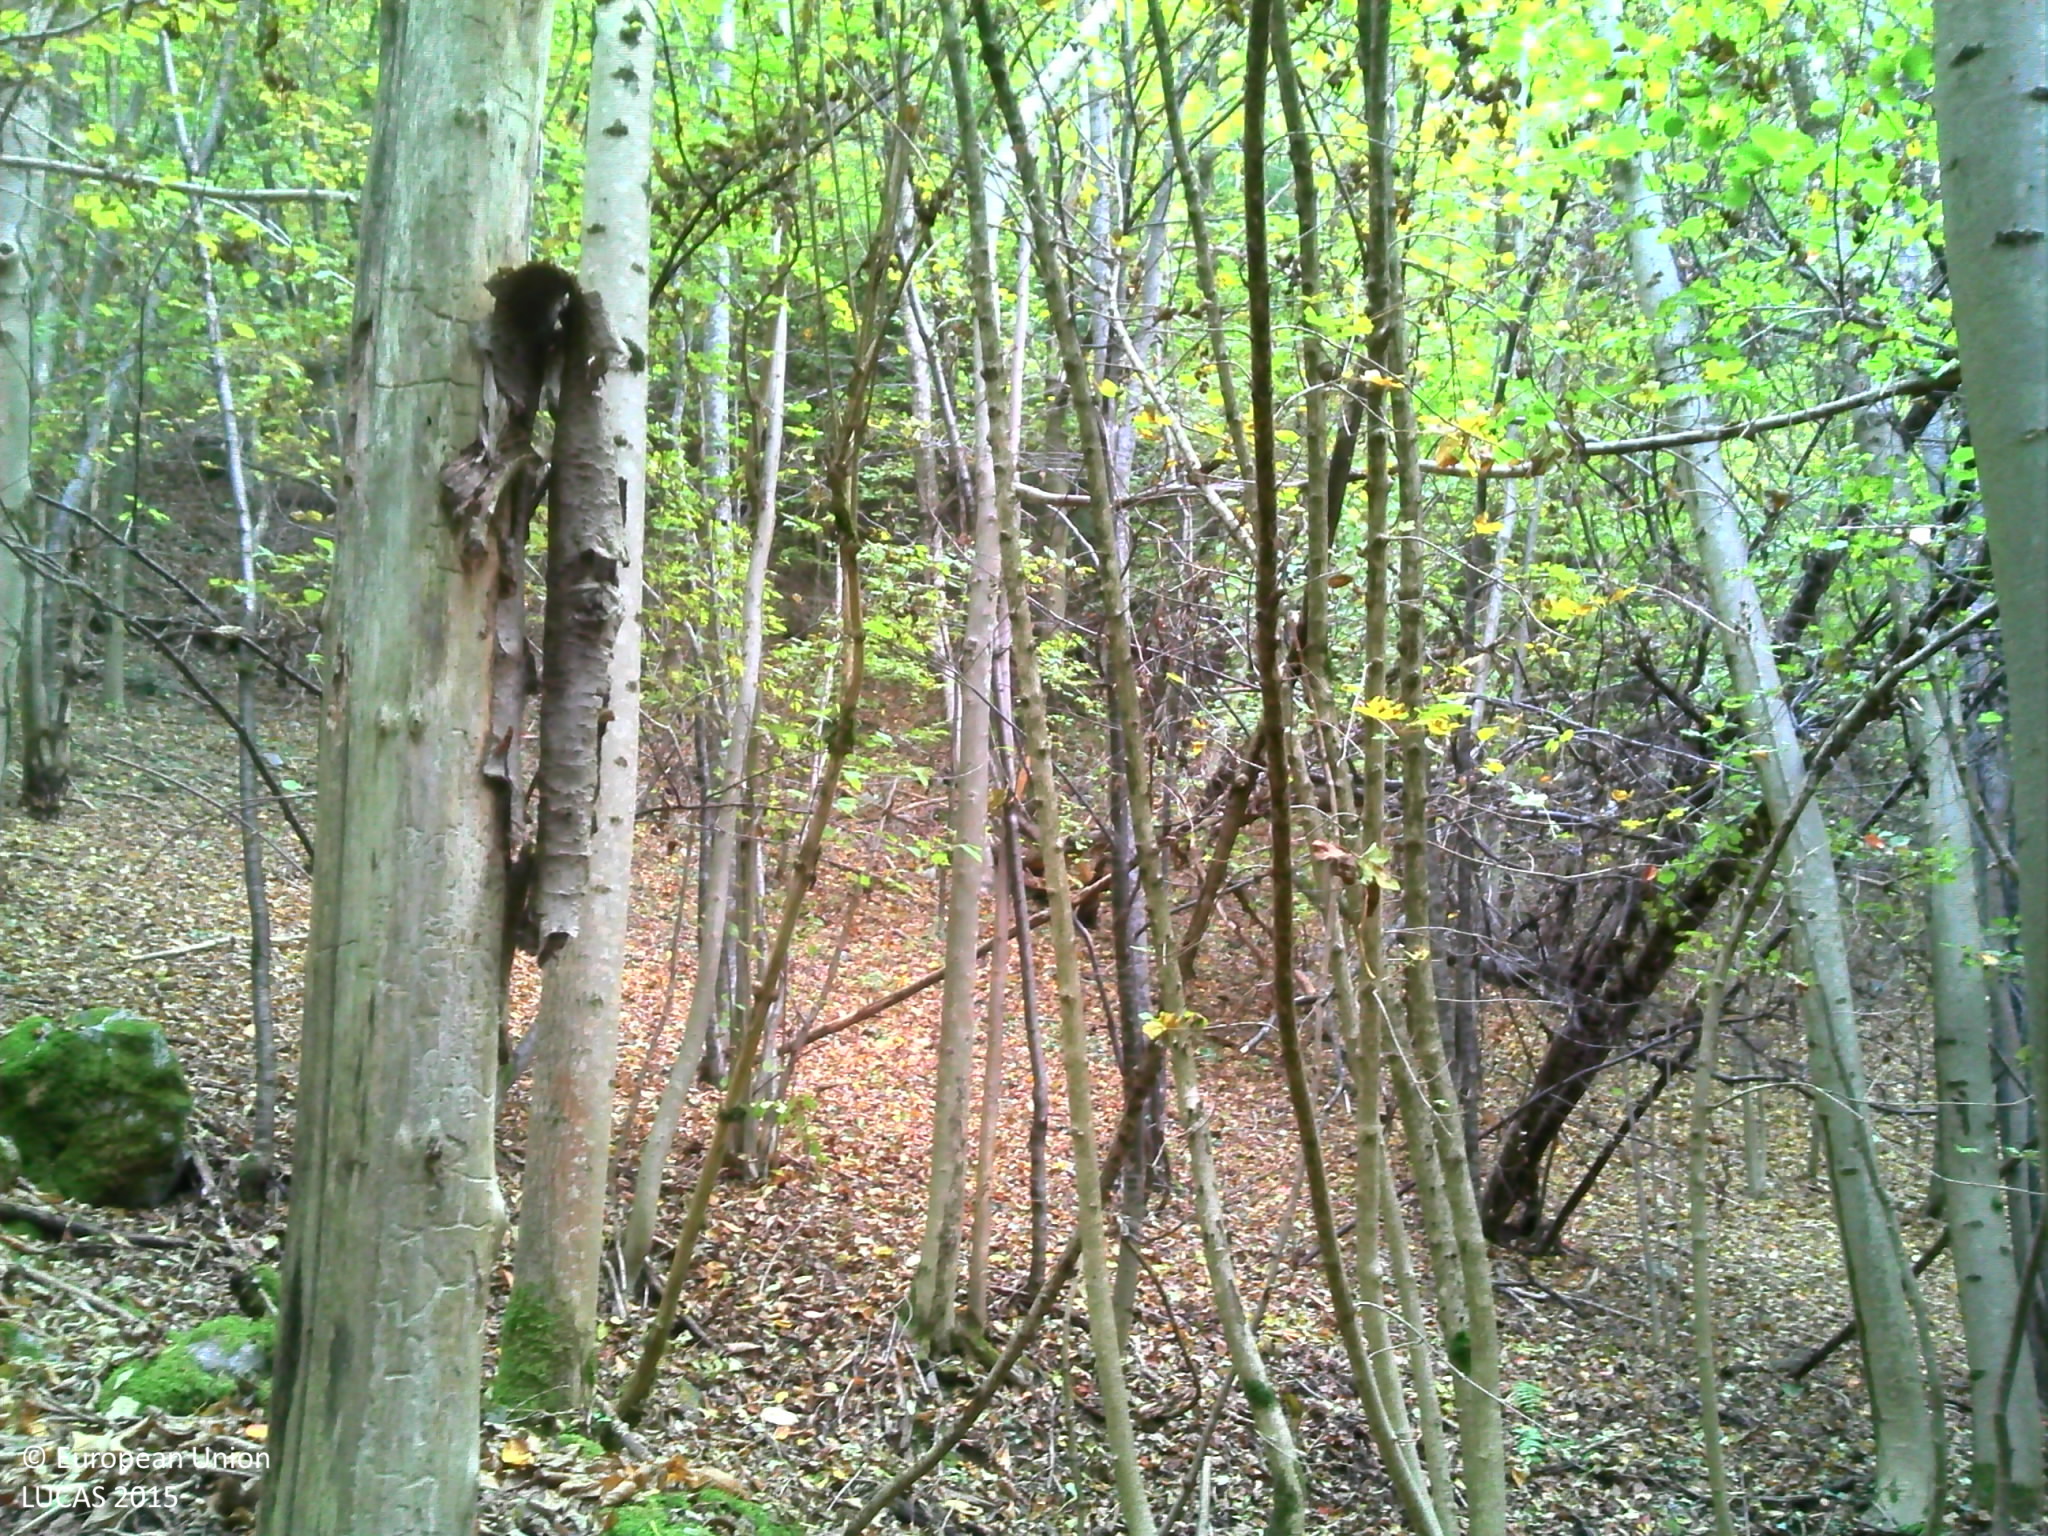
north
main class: Woodland
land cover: Broadleaved woodland
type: mesophytic deciduous forest
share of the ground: > 75 %
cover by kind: broadleaved forest trees 75 %, coniferous forest trees 15 %, unconsolidated bare surface 10 %
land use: Forestry
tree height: > 5 m
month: October
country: FR
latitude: 45.4202
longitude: 6.2604
